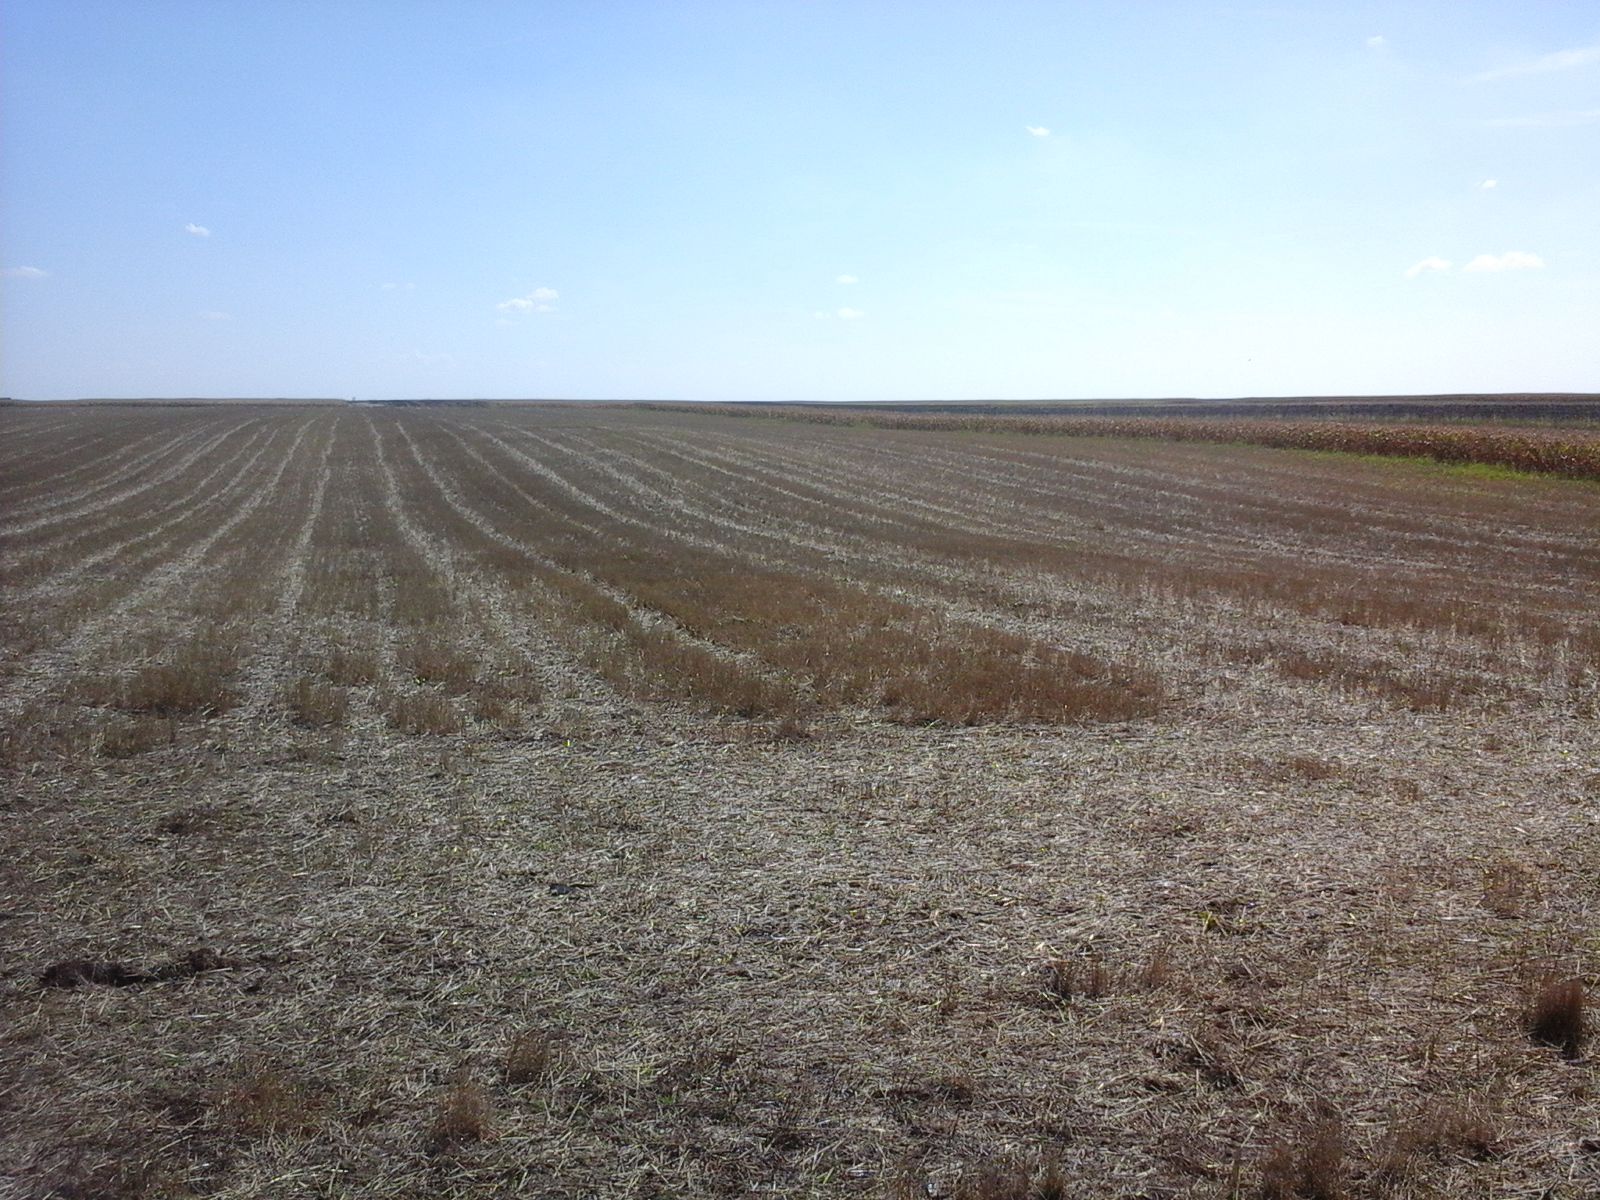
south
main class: Cropland
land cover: Maize
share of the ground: > 75 %
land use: Agriculture (excluding fallow land and kitchen gardens)
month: August
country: RO
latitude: 46.0916
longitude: 21.1677
